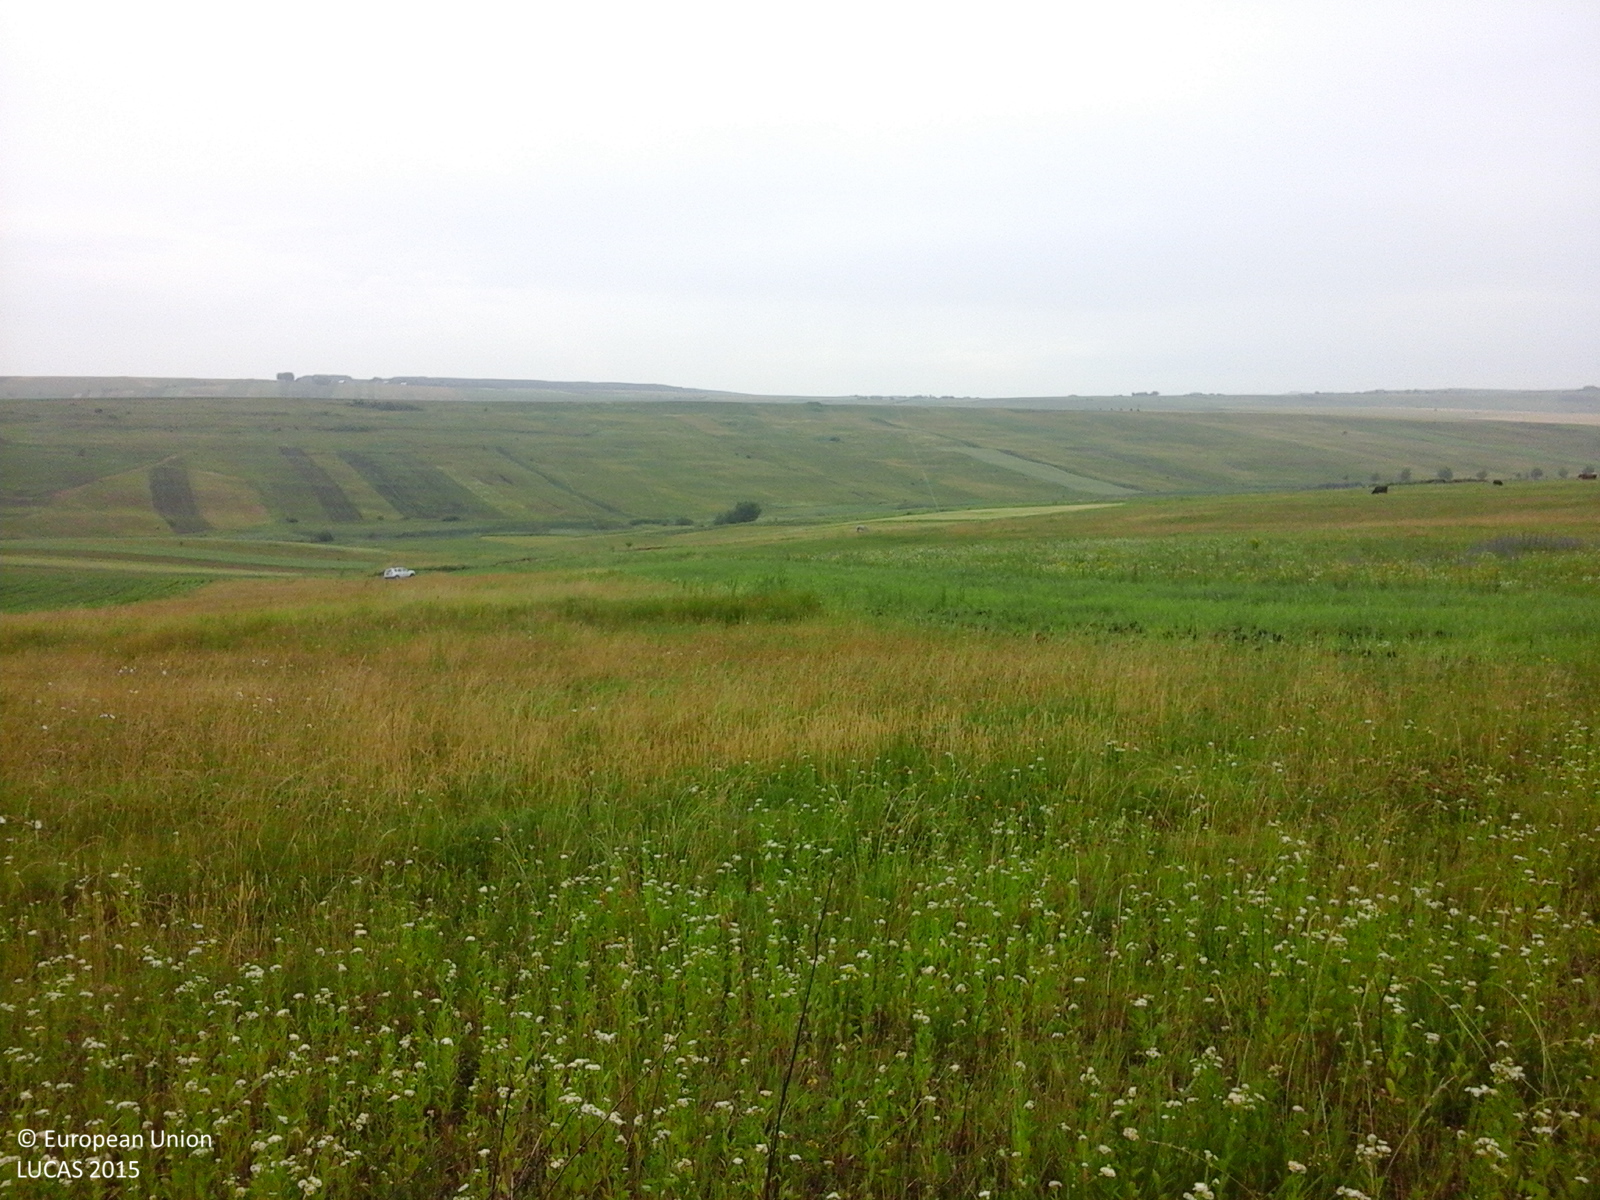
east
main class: Grassland
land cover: Grassland without tree/shrub cover
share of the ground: > 75 %
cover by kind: herbaceous plants 100 %
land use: Agriculture (excluding fallow land and kitchen gardens)
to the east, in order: Grassland without tree/shrub cover; Oats; Grassland without tree/shrub cover; Tracks; Lucerne
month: June
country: RO
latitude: 47.3598
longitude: 26.4650
